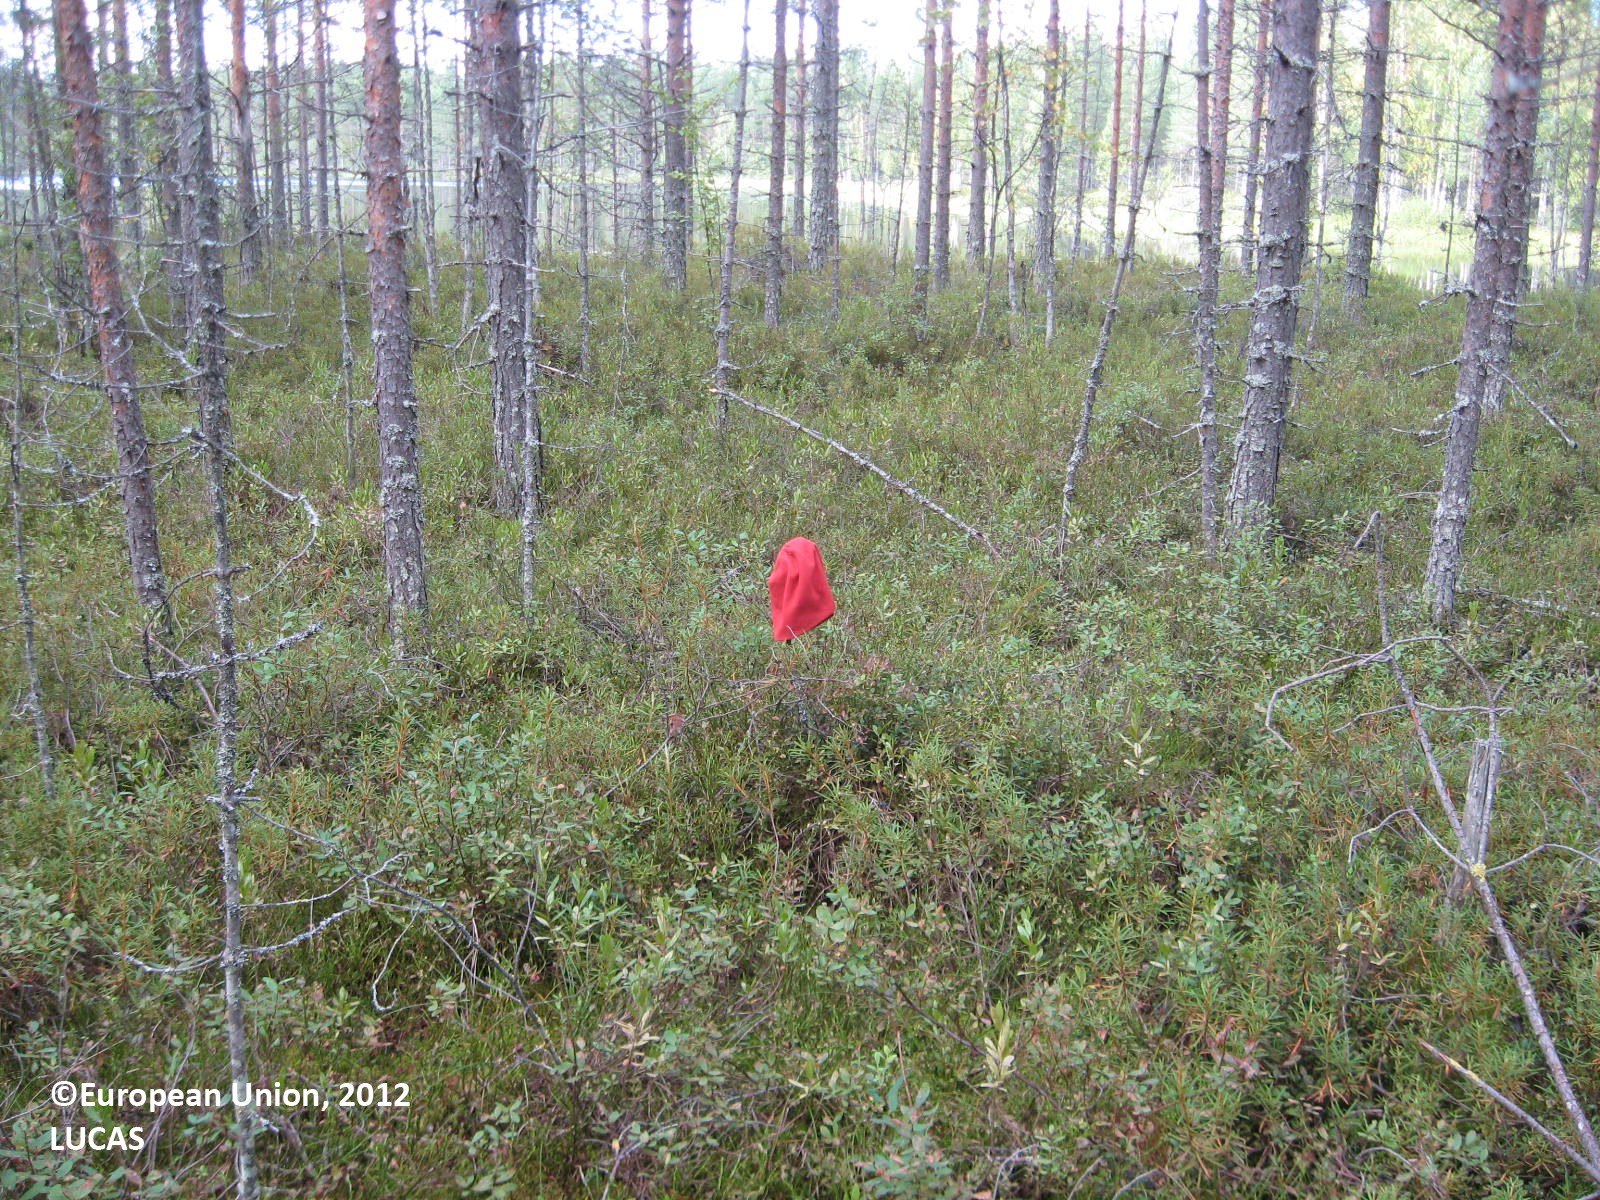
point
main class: Woodland
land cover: Pine dominated coniferous woodland
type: boreal forest
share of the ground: > 75 %
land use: Forestry
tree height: > 5 m
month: August
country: FI
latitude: 63.4198
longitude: 30.1468
